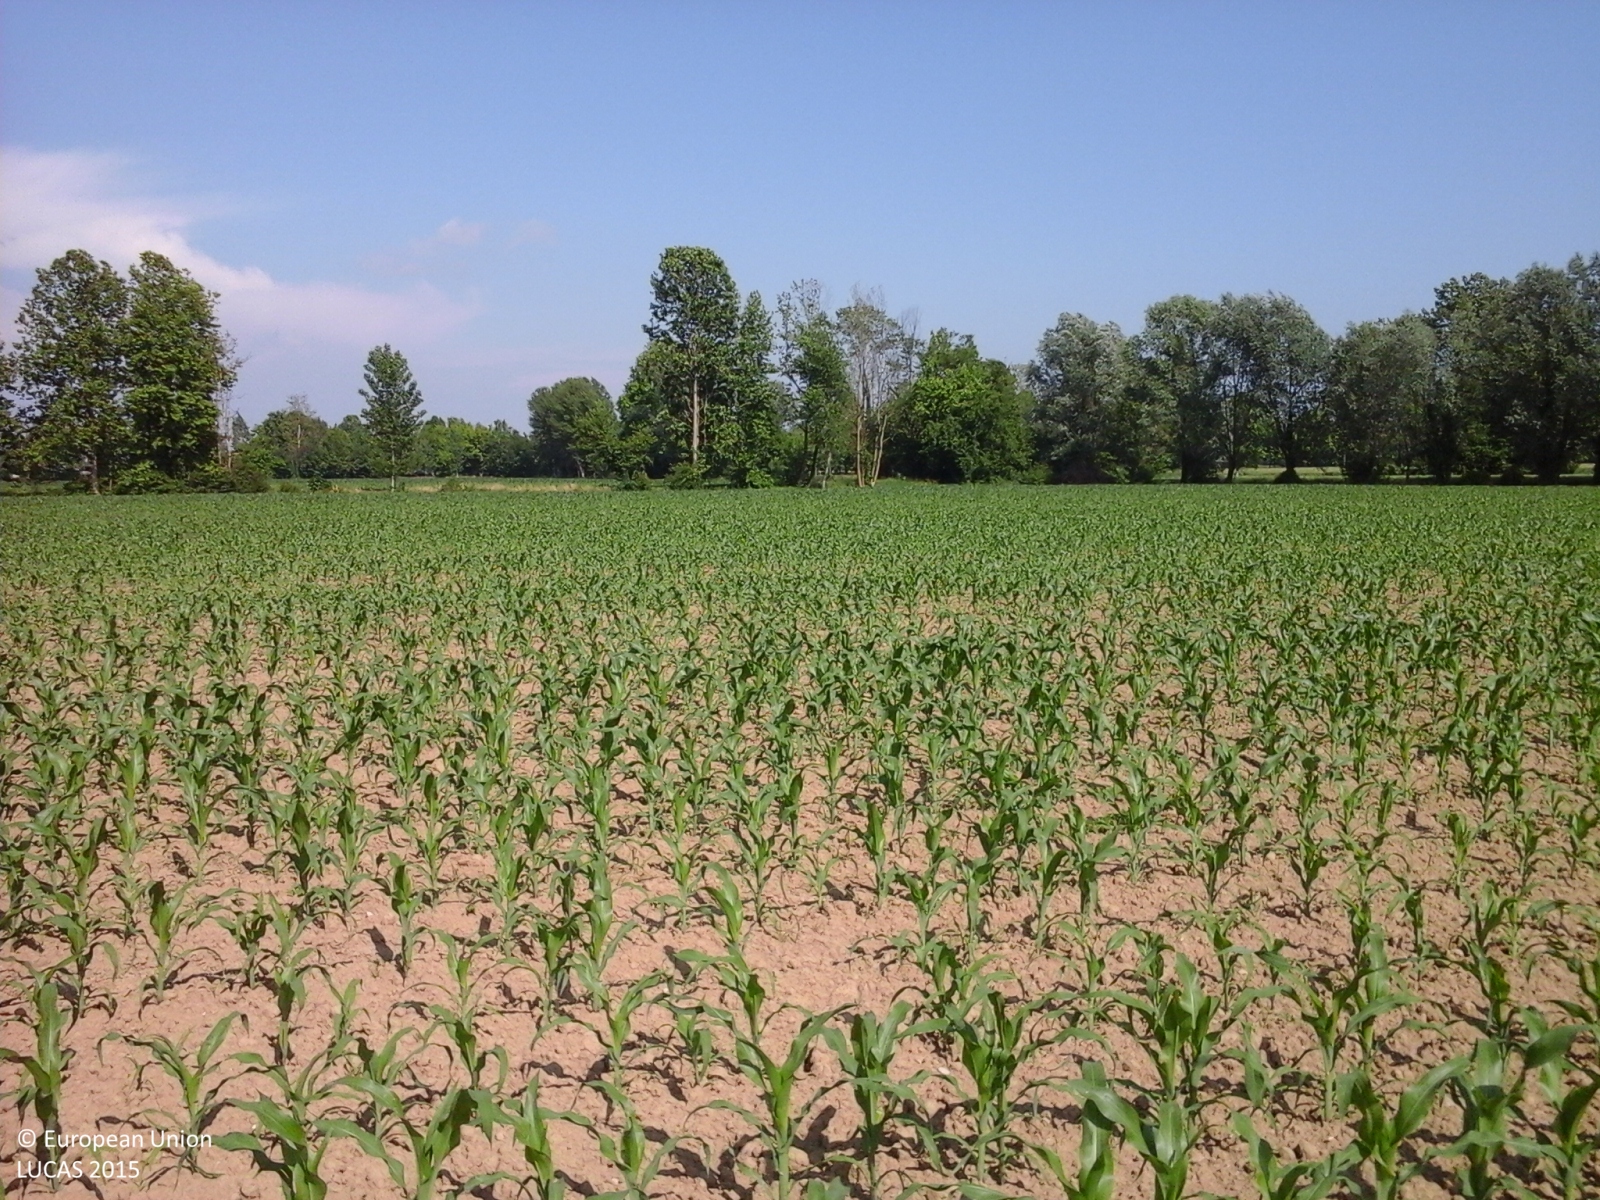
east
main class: Cropland
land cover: Maize
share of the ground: 10 - 25 %
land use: Agriculture (excluding fallow land and kitchen gardens)
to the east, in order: Maize; Grass margins; Ditches and canals; Abandoned hedges; Maize
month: May
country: IT
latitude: 45.4679
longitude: 9.6808
